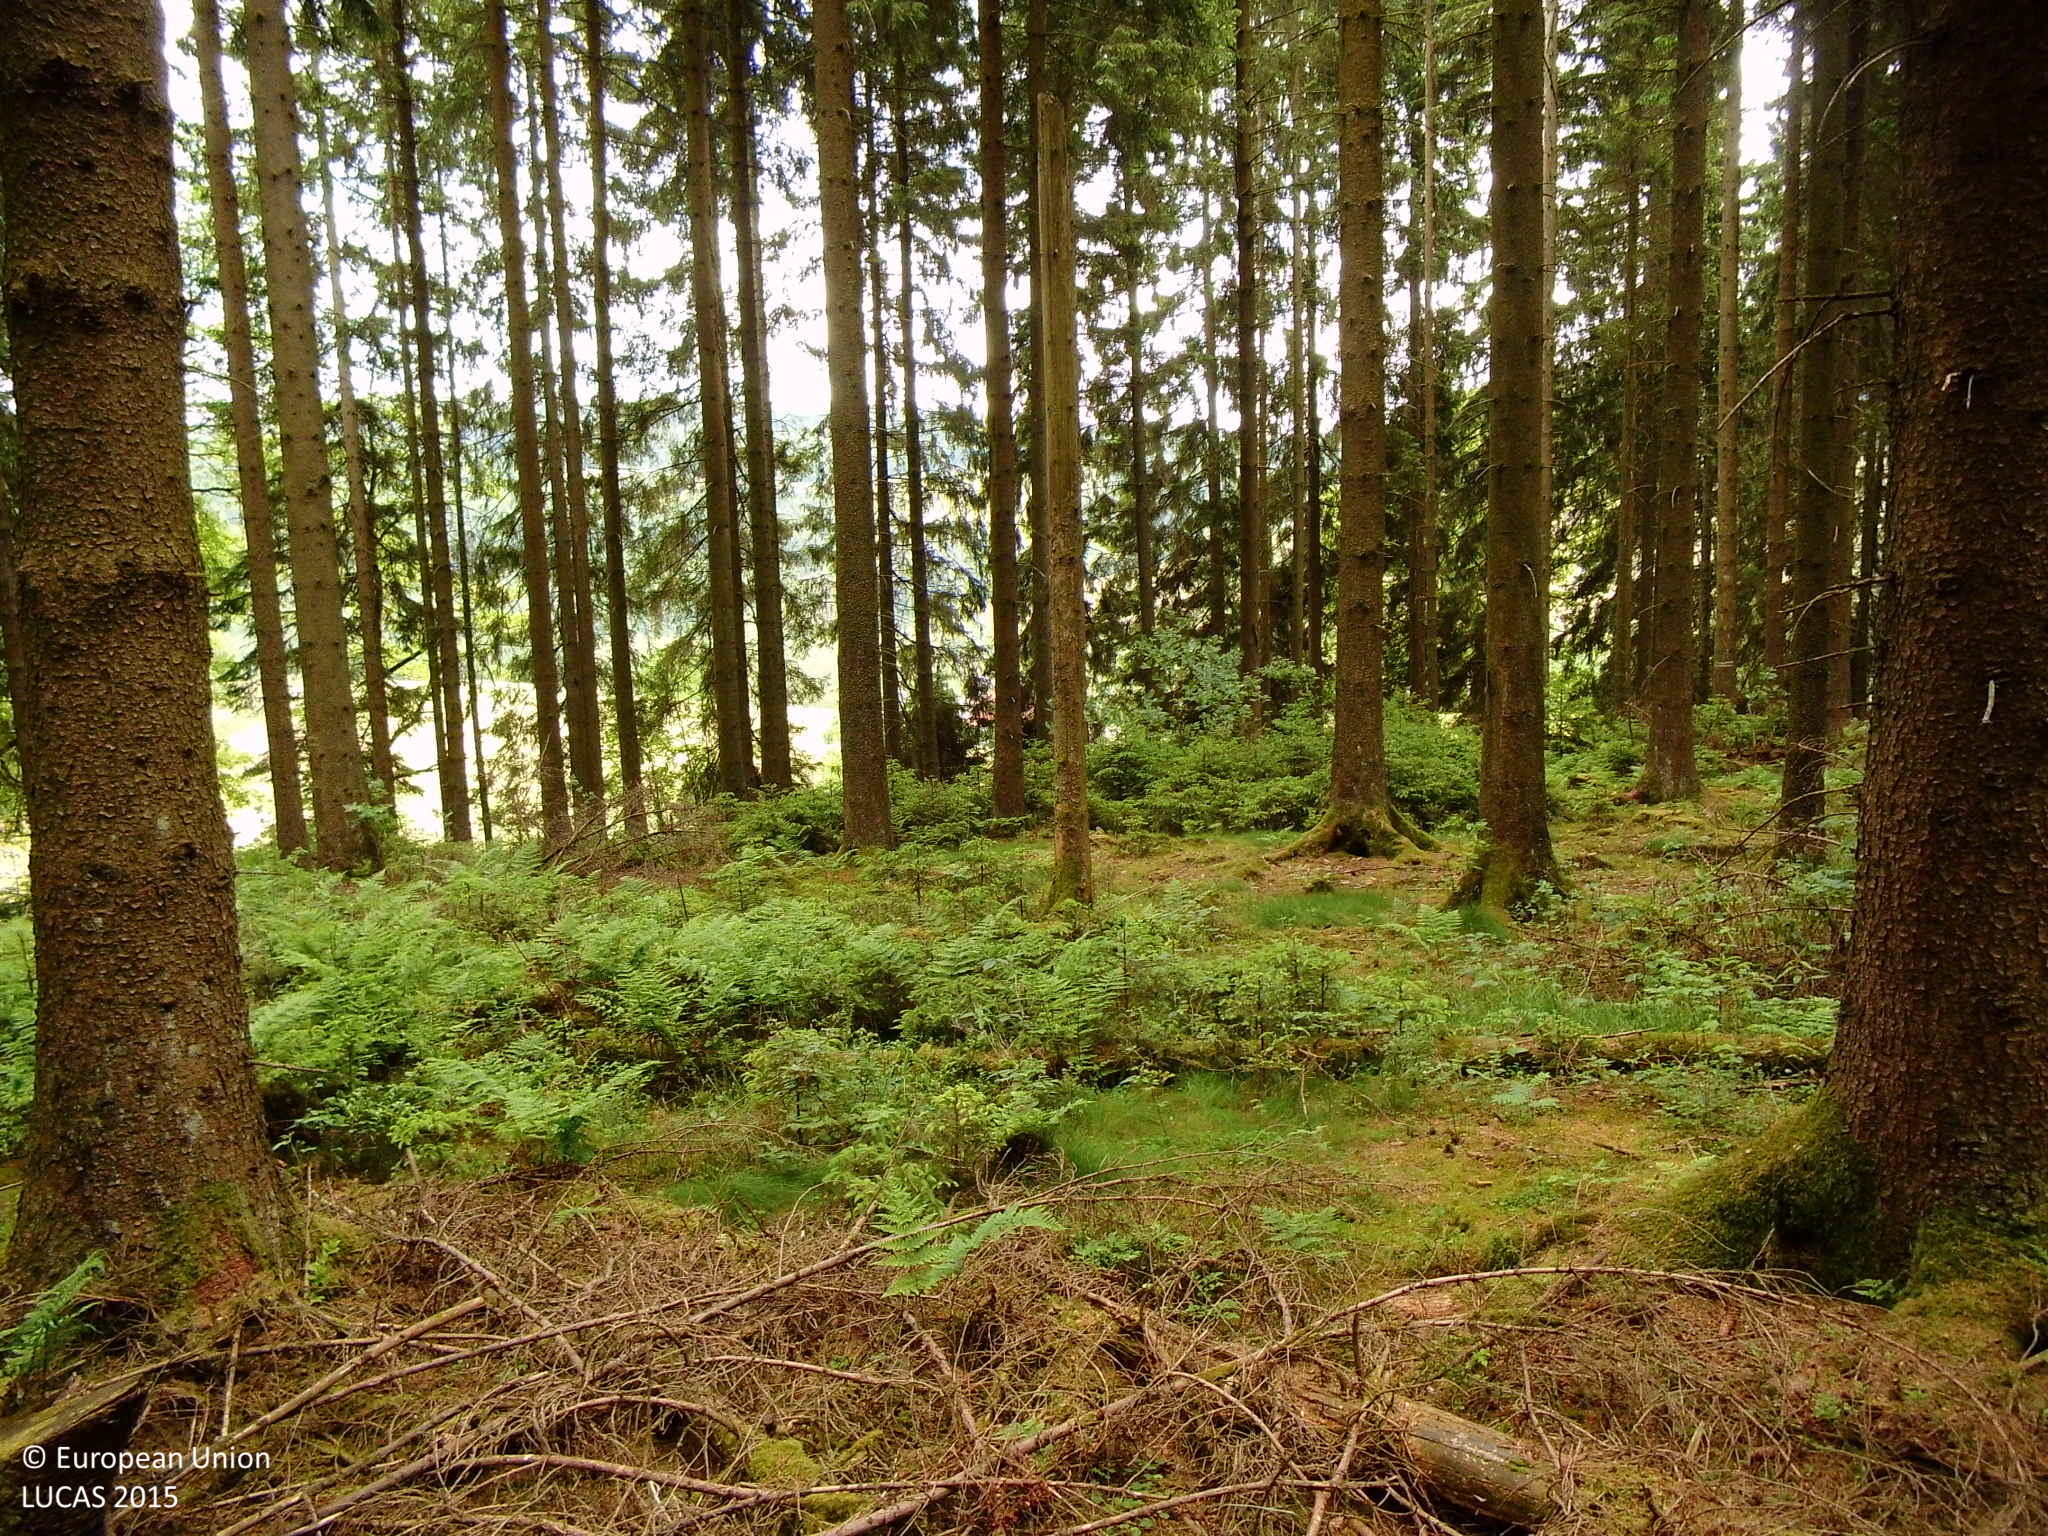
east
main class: Woodland
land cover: Spruce dominated coniferous woodland
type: hemiboreal forest and nemoral coniferous forest and mixed broadleaved-coniferous forest
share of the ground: > 75 %
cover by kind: coniferous forest trees 75 %, shrubs 10 %, lichens and mosses 10 %, herbaceous plants 5 %
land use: Forestry
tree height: > 5 m
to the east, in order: Spruce dominated coniferous woodland; Groves; Grassland without tree/shrub cover; Rivers and streams; Grassland without tree/shrub cover
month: June
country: DE
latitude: 51.0488
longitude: 8.0461
